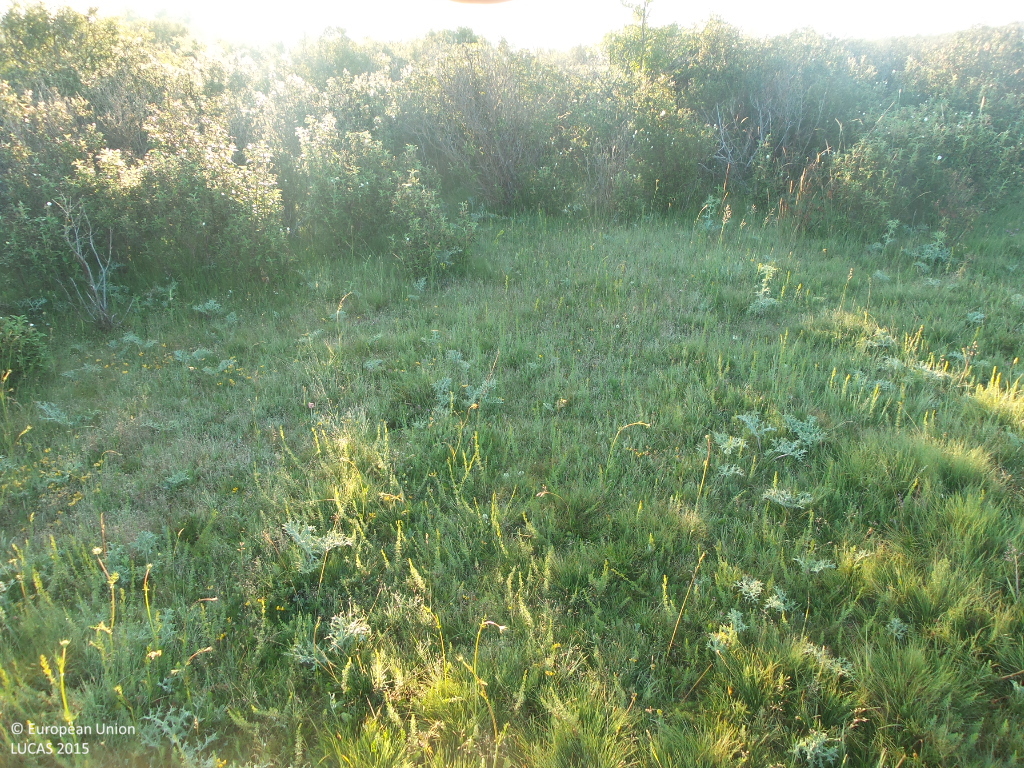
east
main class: Shrubland
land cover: Shrubland without tree cover
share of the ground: 50 - 75 %
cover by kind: shrubs 55 %, herbaceous plants 45 %
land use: Semi-natural and natural areas not in use
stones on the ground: < 10 %
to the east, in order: Shrubland without tree cover; Tracks; Shrubland without tree cover; Tracks; Shrubland without tree cover; Tracks; Shrubland without tree cover
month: June
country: ES
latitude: 41.2205
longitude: -3.0528
